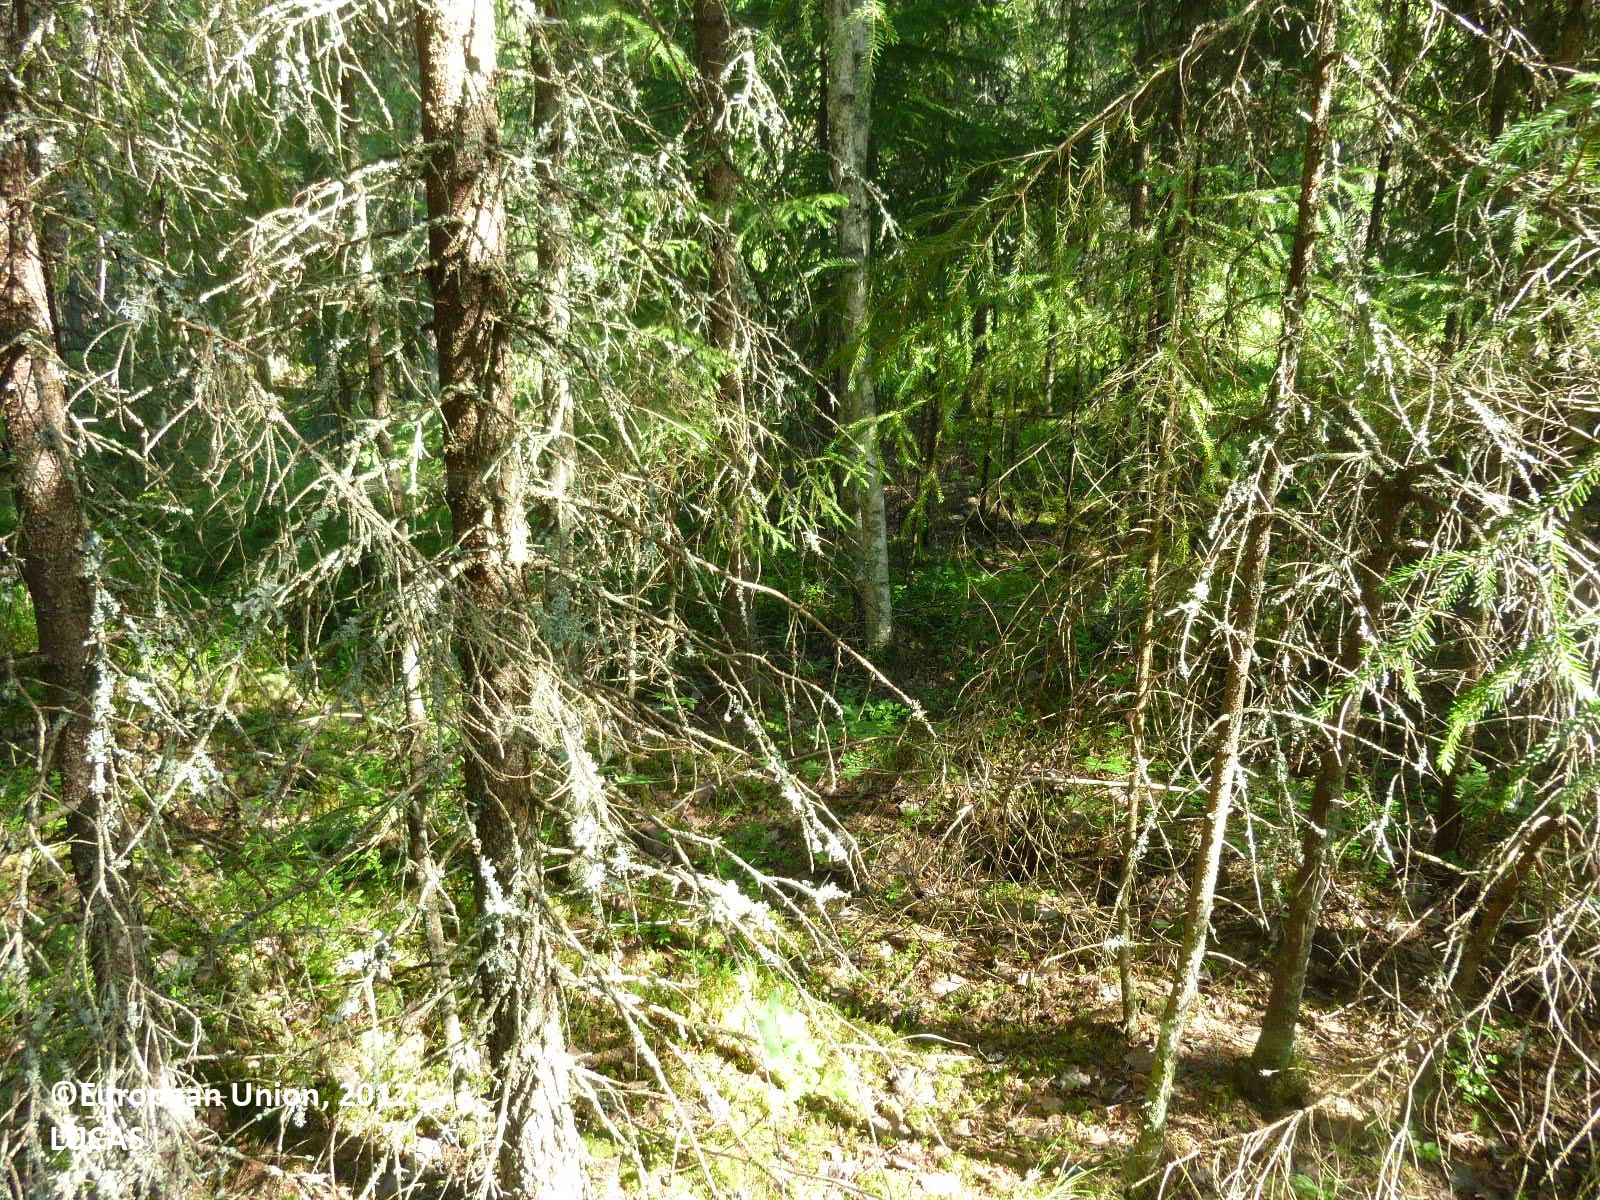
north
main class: Woodland
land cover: Spruce dominated coniferous woodland
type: boreal forest
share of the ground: > 75 %
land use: Forestry
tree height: > 5 m
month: July
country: FI
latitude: 61.1326
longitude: 22.5634
